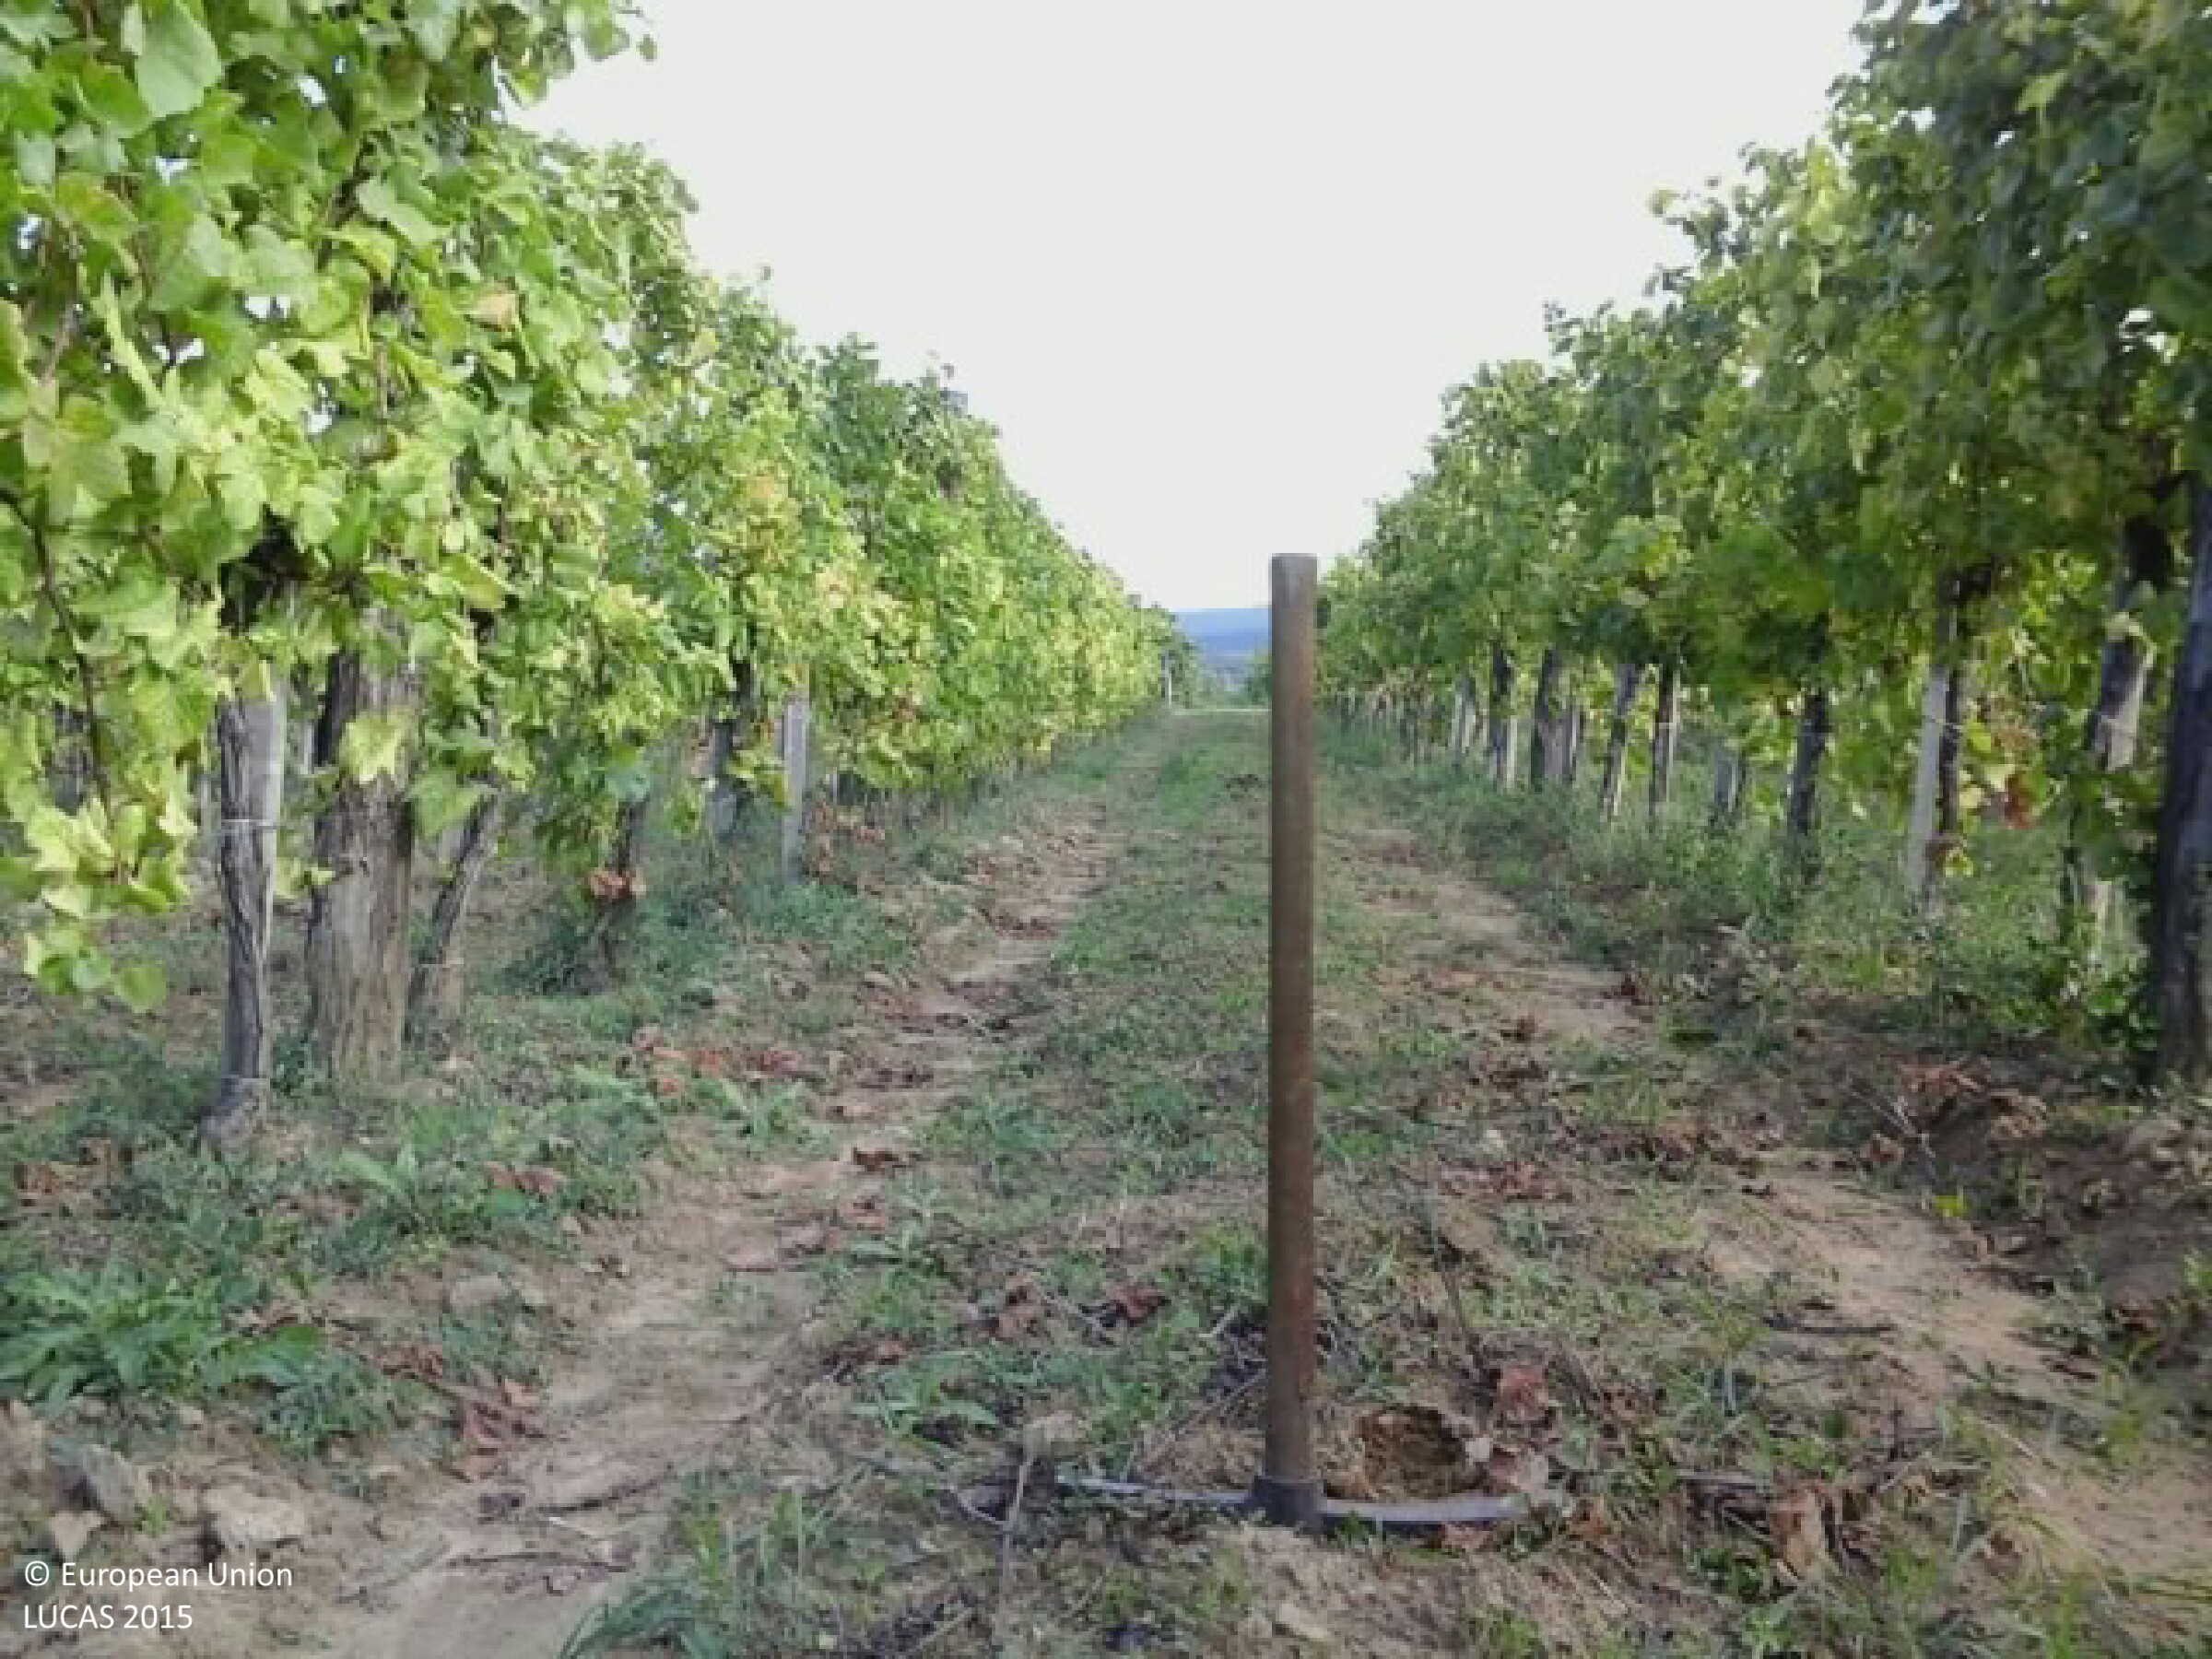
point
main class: Cropland
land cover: Vineyards
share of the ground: > 75 %
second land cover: Other bare soil
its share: > 75 %
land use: Agriculture (excluding fallow land and kitchen gardens)
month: September
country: HU
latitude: 47.7861
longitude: 19.9978
